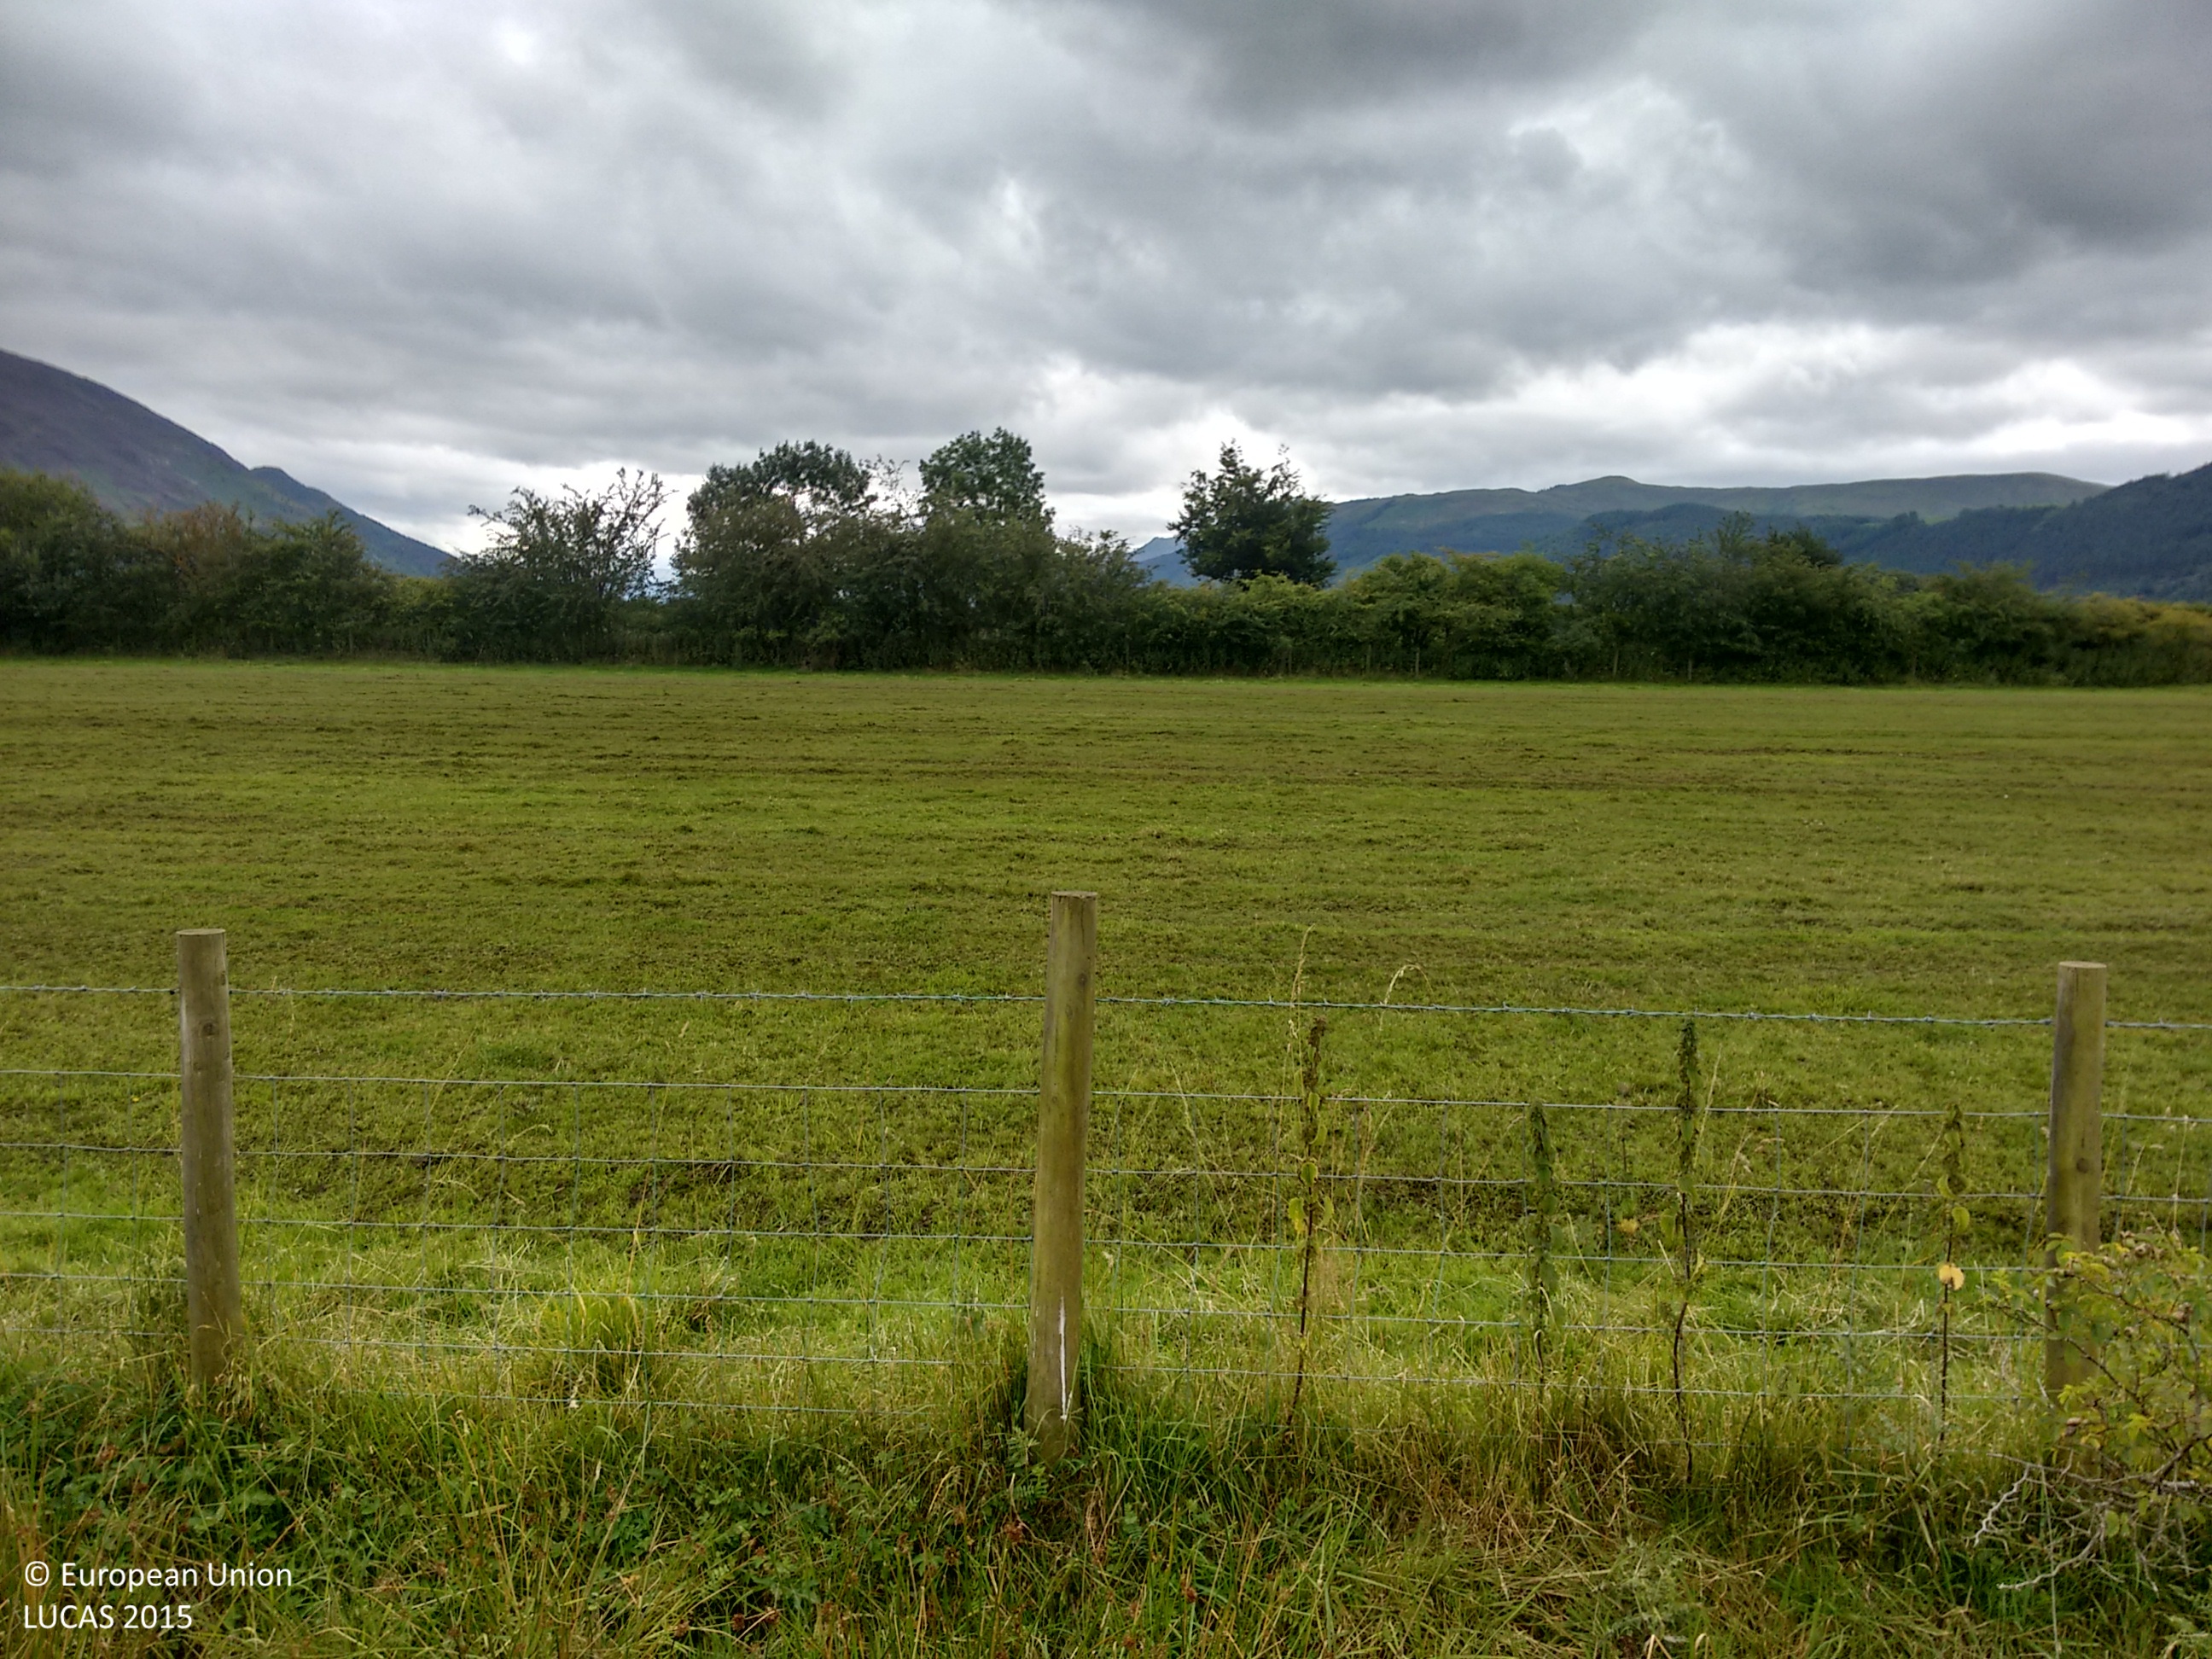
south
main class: Grassland
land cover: Grassland without tree/shrub cover
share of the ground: > 75 %
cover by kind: herbaceous plants 100 %
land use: Agriculture (excluding fallow land and kitchen gardens)
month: August
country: GB
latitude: 54.6796
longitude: -3.2125
